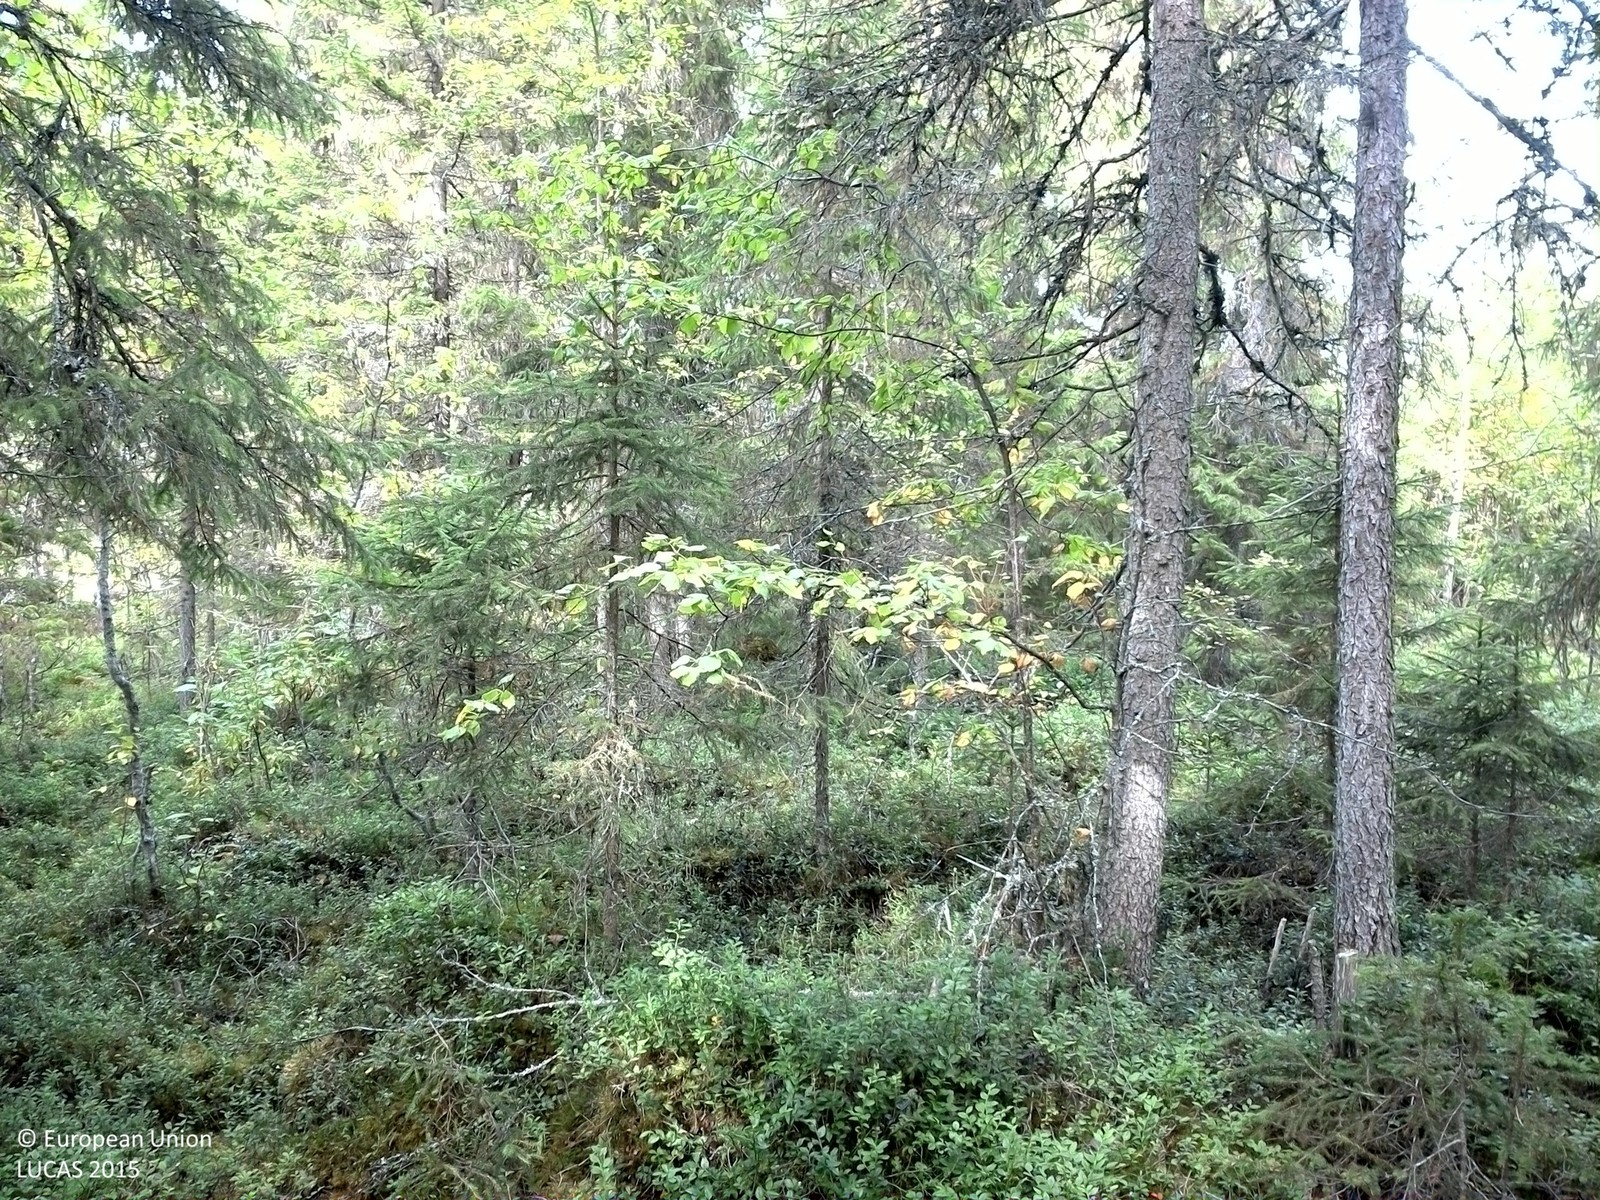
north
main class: Woodland
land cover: Spruce dominated coniferous woodland
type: boreal forest
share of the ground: > 75 %
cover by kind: coniferous forest trees 55 %, shrubs 25 %, broadleaved forest trees 10 %, lichens and mosses 10 %
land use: Forestry
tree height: > 5 m
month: September
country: SE
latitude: 64.0277
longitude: 16.5403
